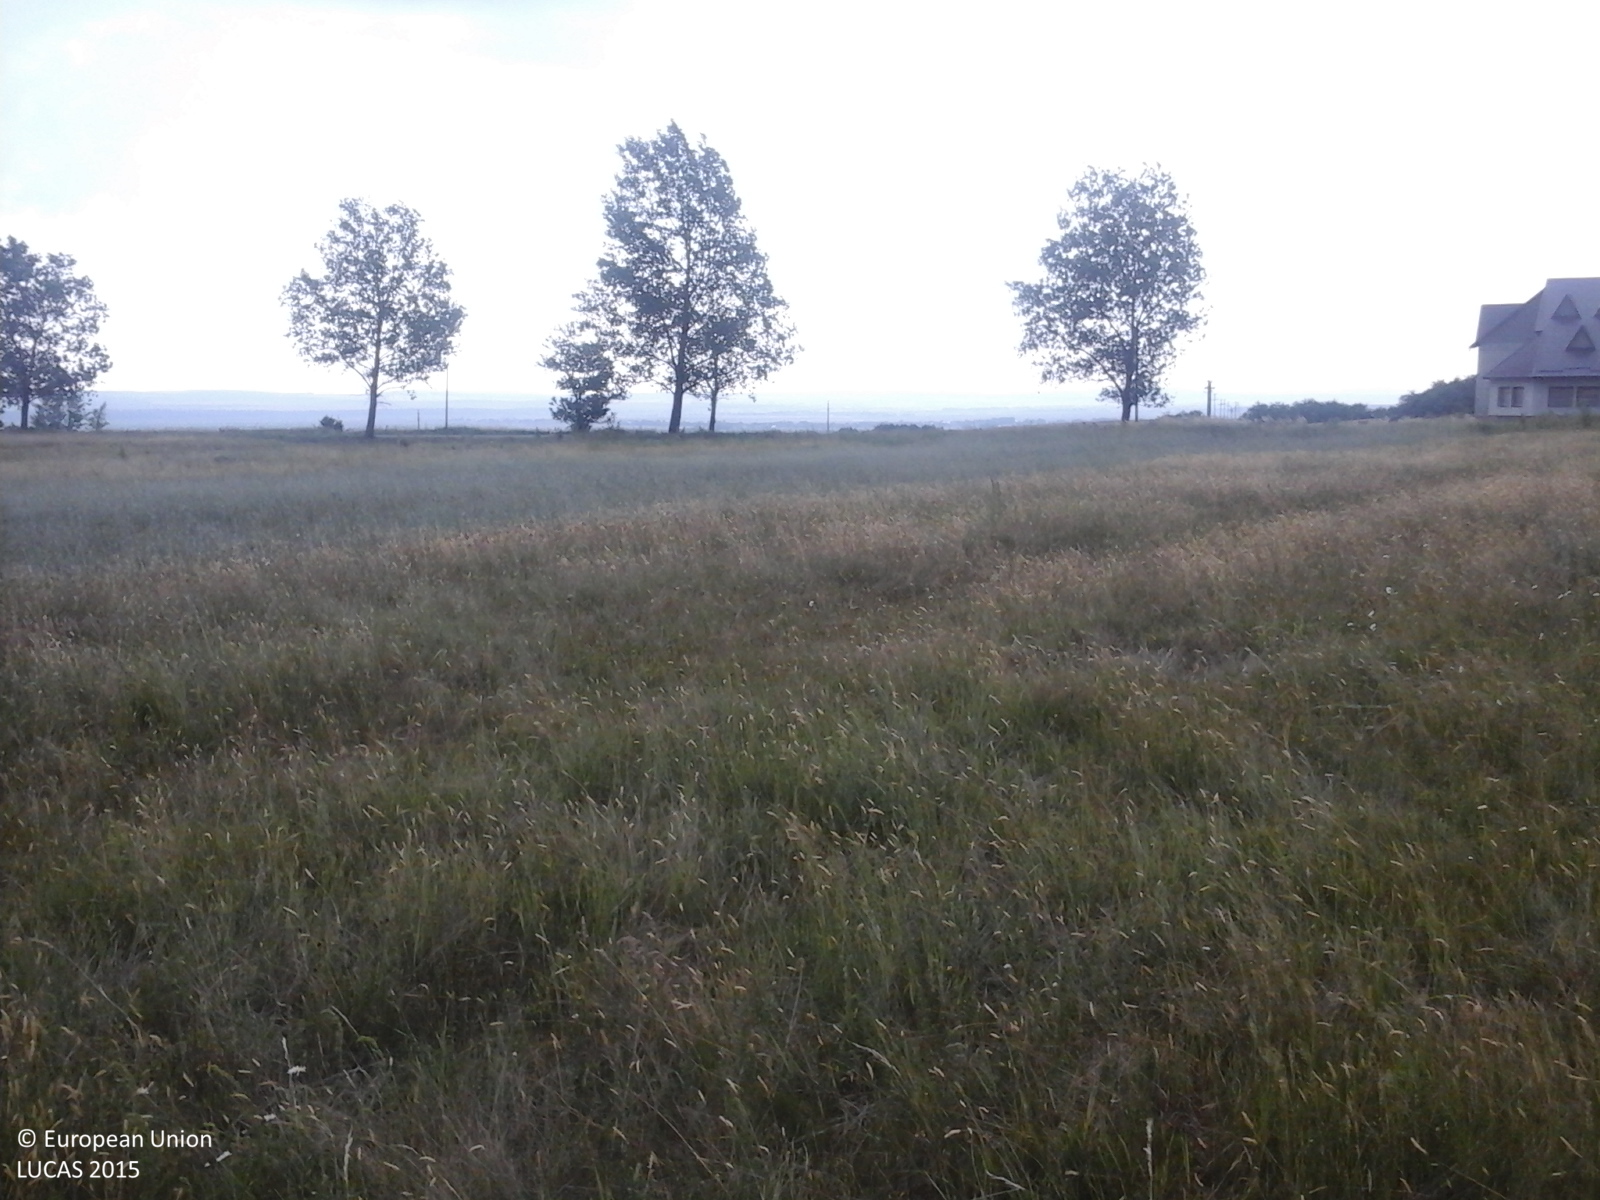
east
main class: Grassland
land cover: Grassland without tree/shrub cover
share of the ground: > 75 %
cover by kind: herbaceous plants 100 %
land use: Agriculture (excluding fallow land and kitchen gardens)
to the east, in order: Grassland without tree/shrub cover; Lines of trees; Grass margins; Ditches and canals; Grass margins; Paved roads, cycling and walking lanes; Grass margins; Ditches and canals; Grass margins; Lines of trees; Electric lines; Lucerne; Grass margins; Ditches and canals; Grass margins; Lucerne; Grass margins; Ditches and canals; Grass margins; Lucerne; Abandoned hedges; Grassland without tree/shrub cover
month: June
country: RO
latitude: 47.2627
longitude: 26.3793
